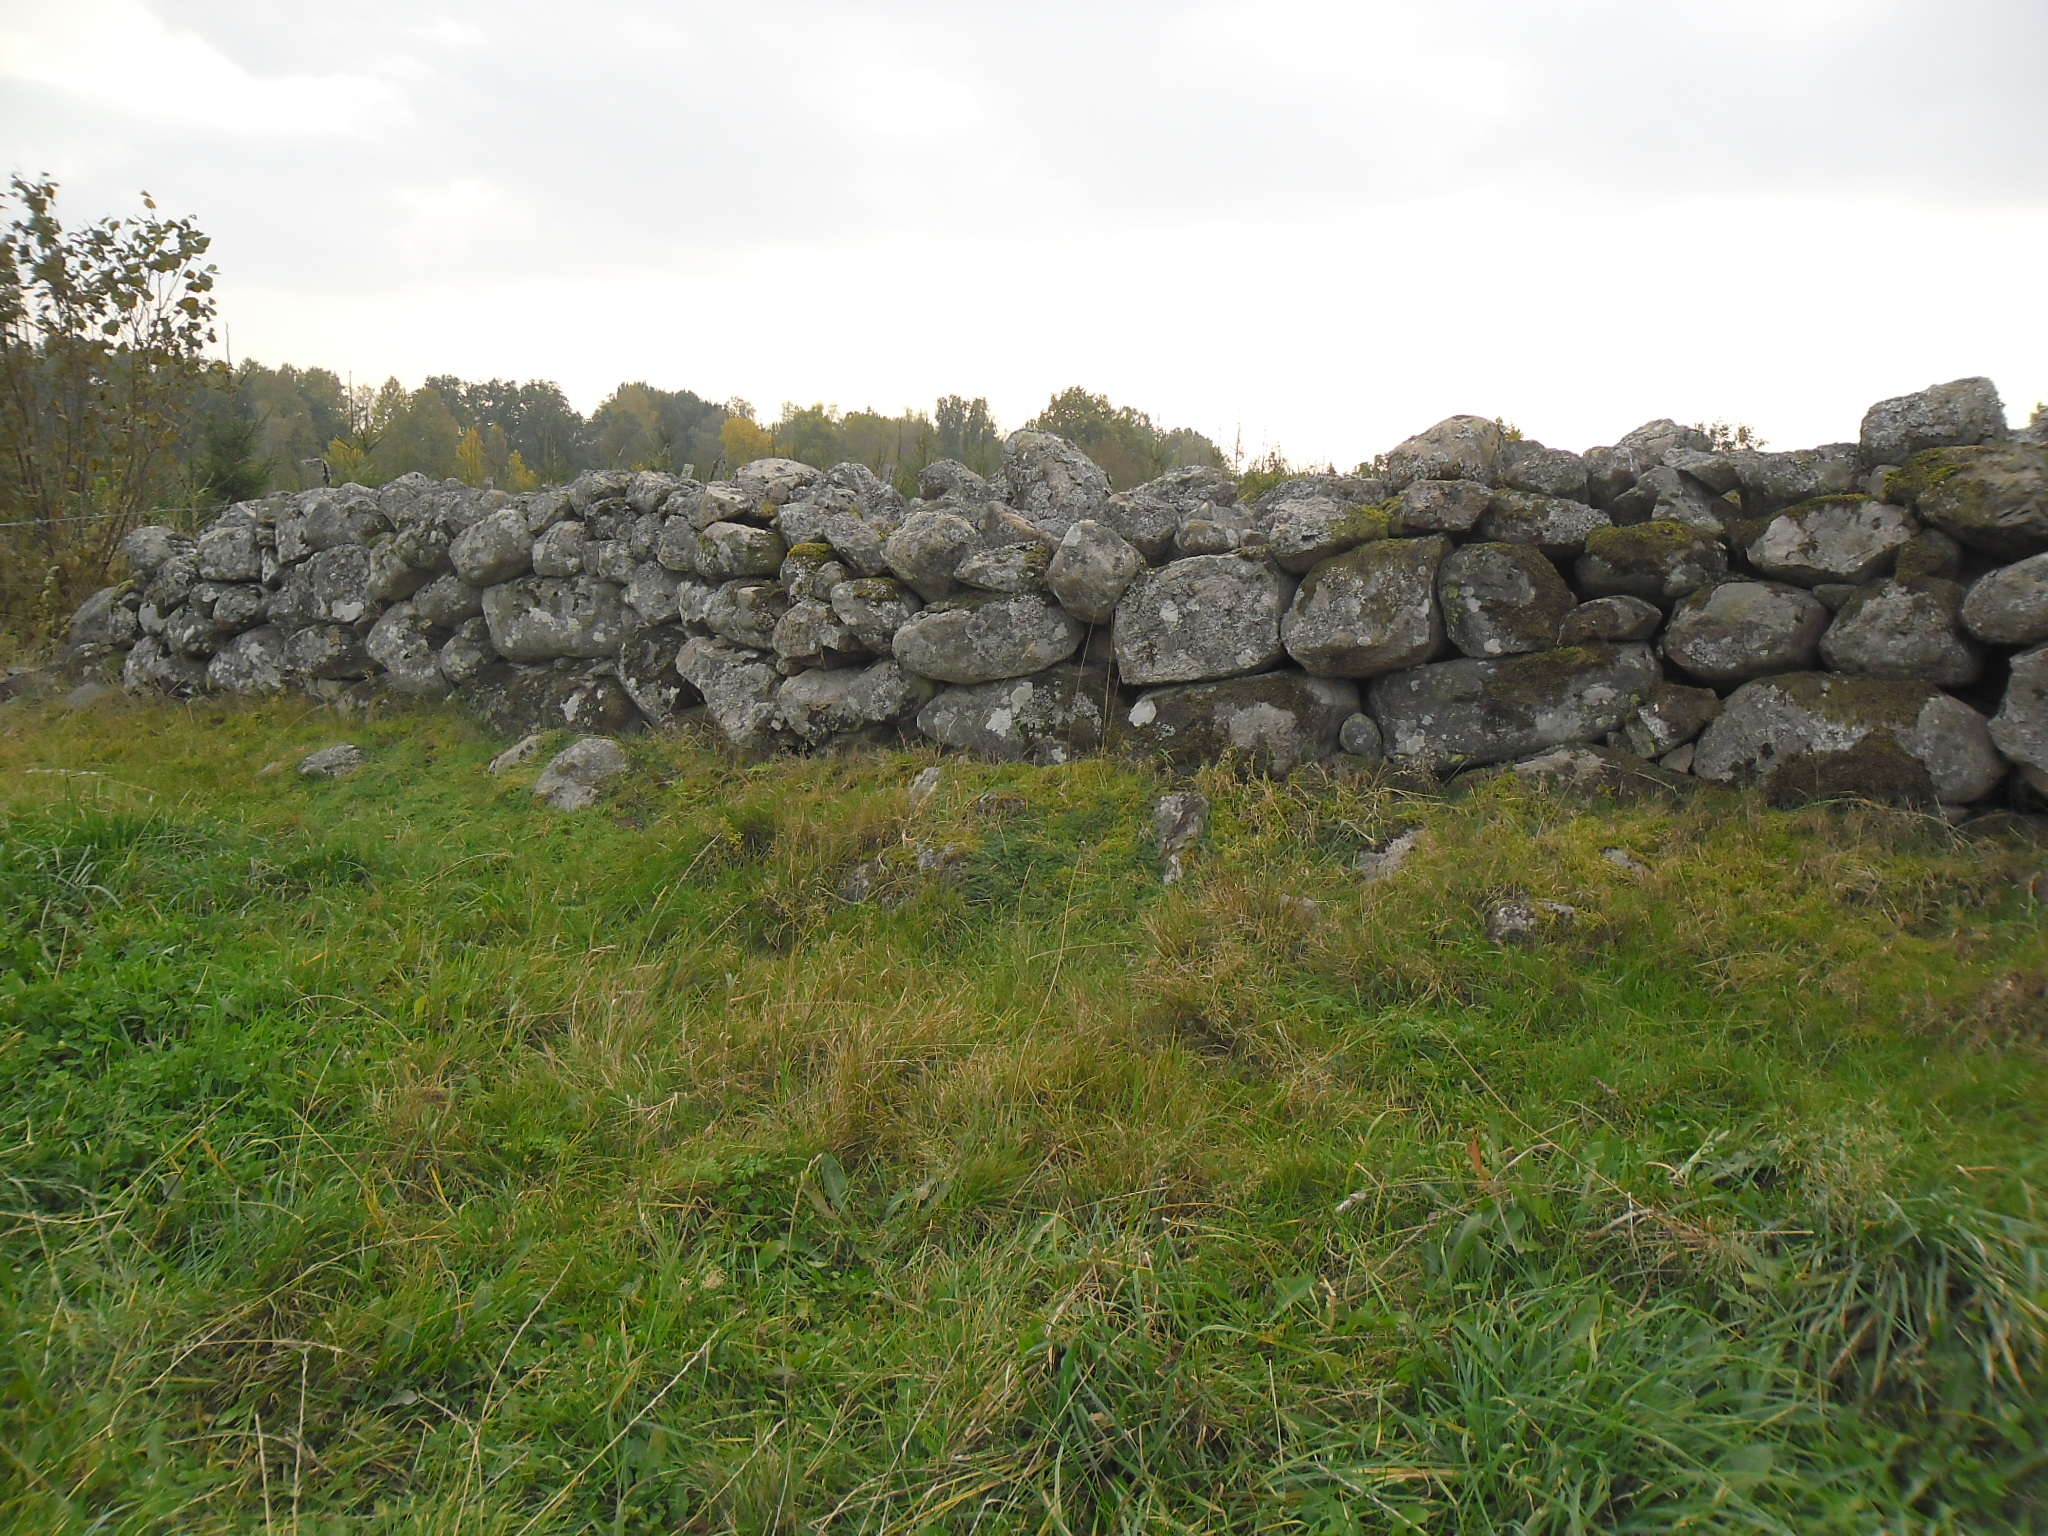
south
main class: Grassland
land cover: Grassland without tree/shrub cover
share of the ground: > 75 %
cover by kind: herbaceous plants 100 %
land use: Agriculture (excluding fallow land and kitchen gardens)
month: October
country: SE
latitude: 56.2597
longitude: 13.7265
